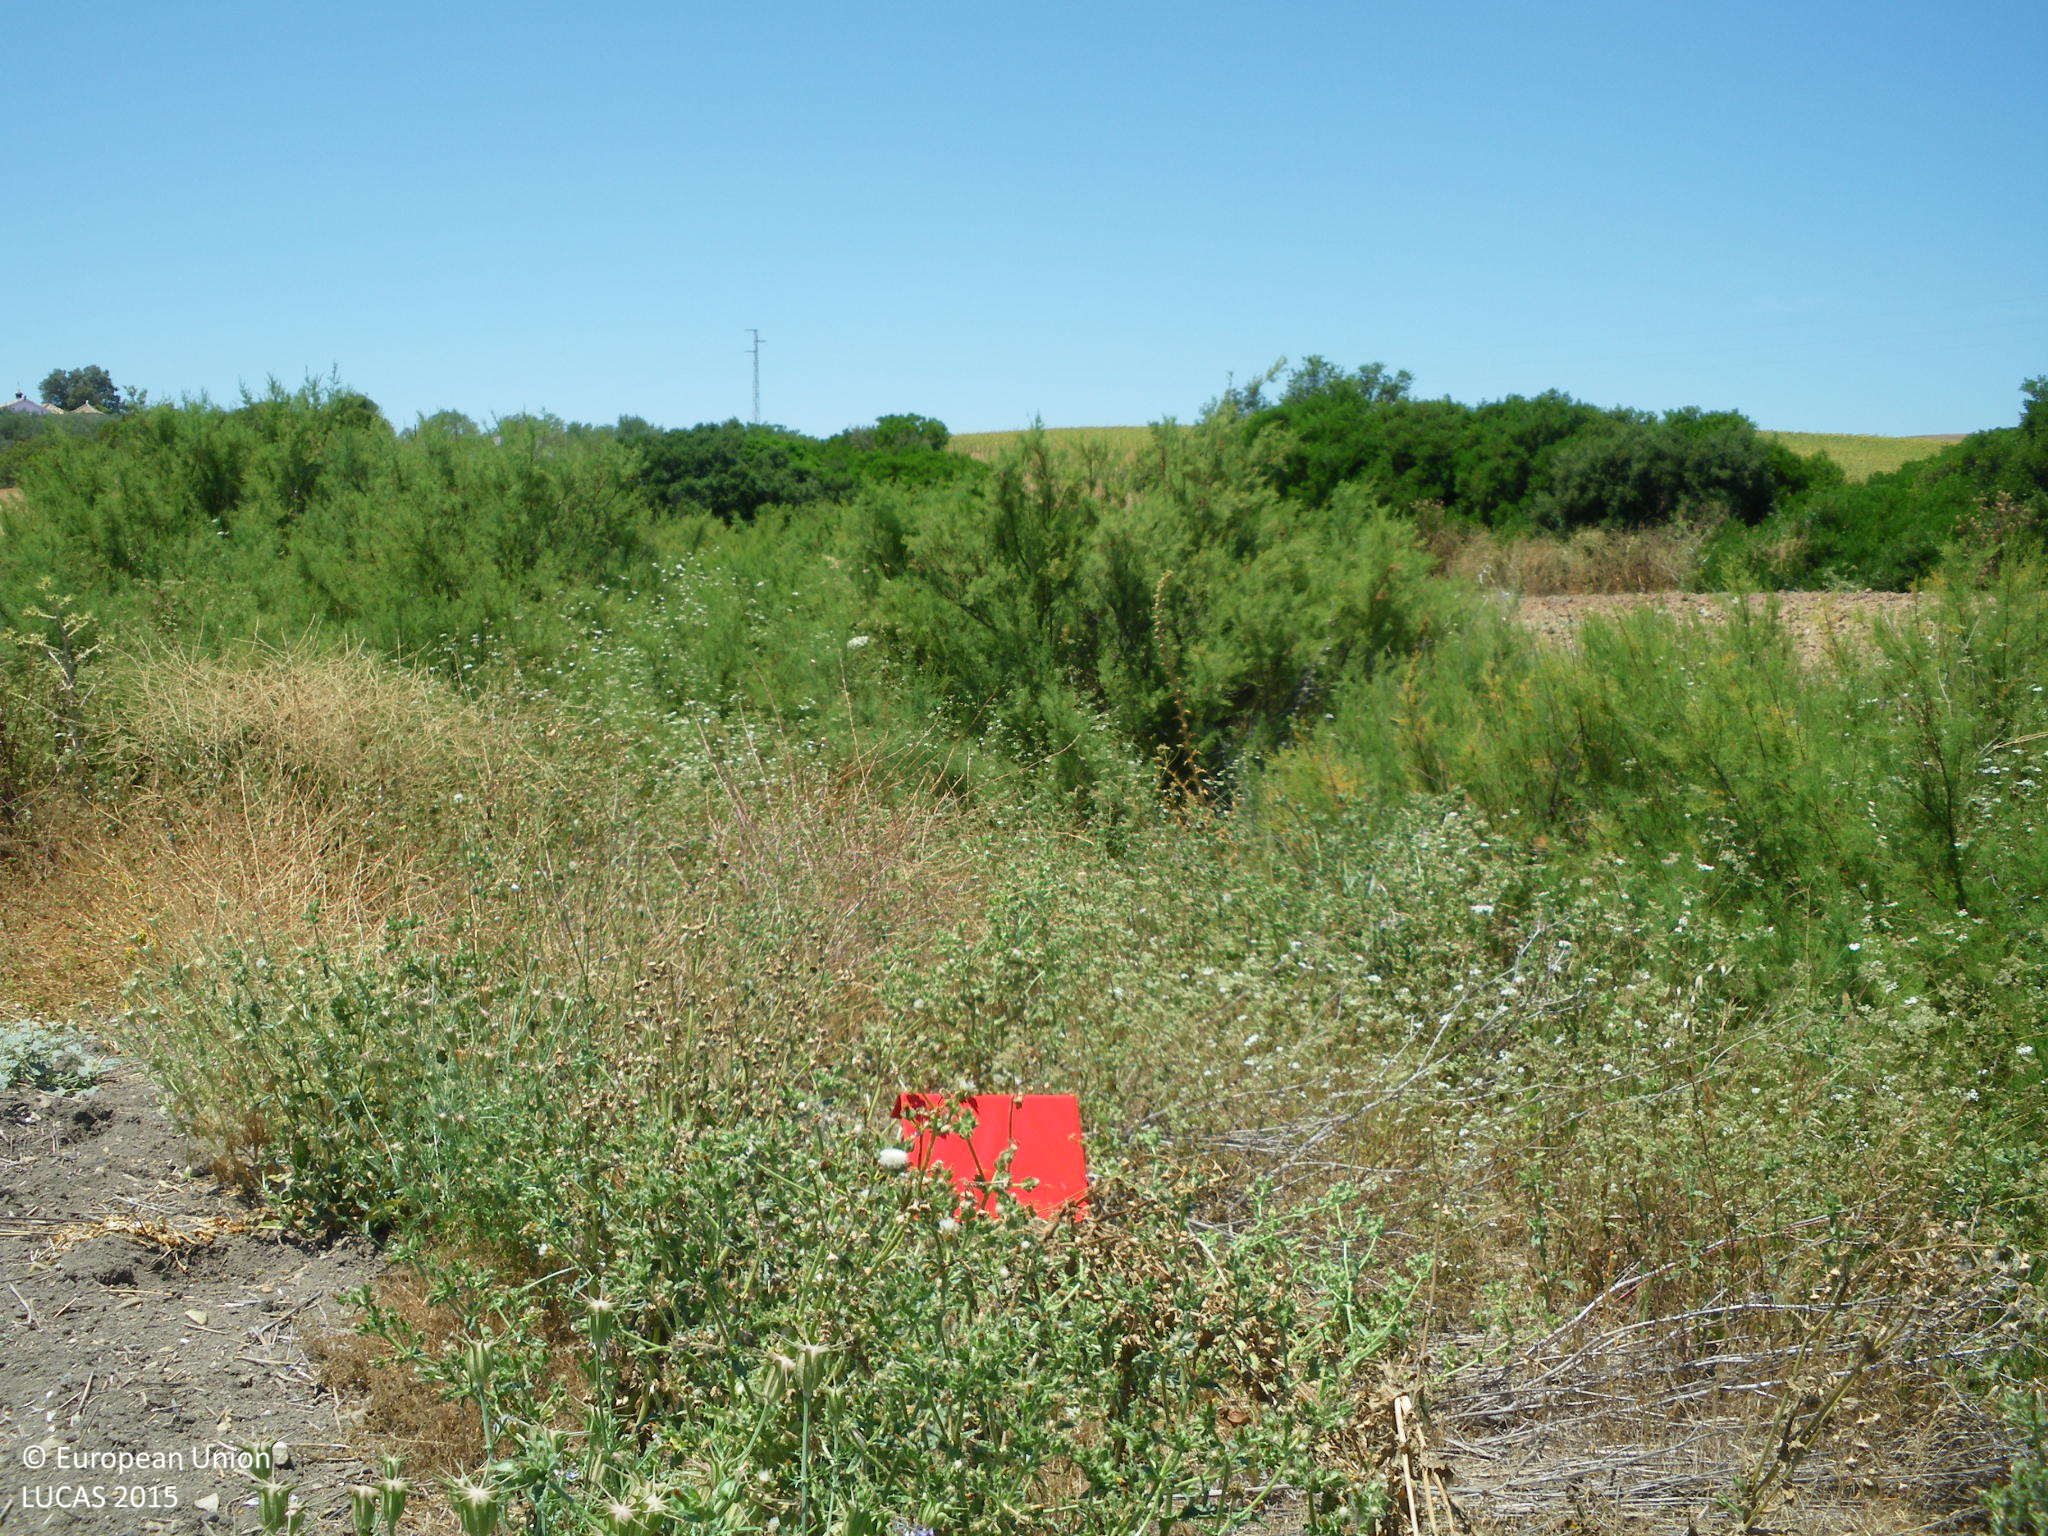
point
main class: Grassland
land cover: Grassland without tree/shrub cover
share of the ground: > 75 %
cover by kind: herbaceous plants 100 %
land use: Semi-natural and natural areas not in use
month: June
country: ES
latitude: 36.9006
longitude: -5.7784
